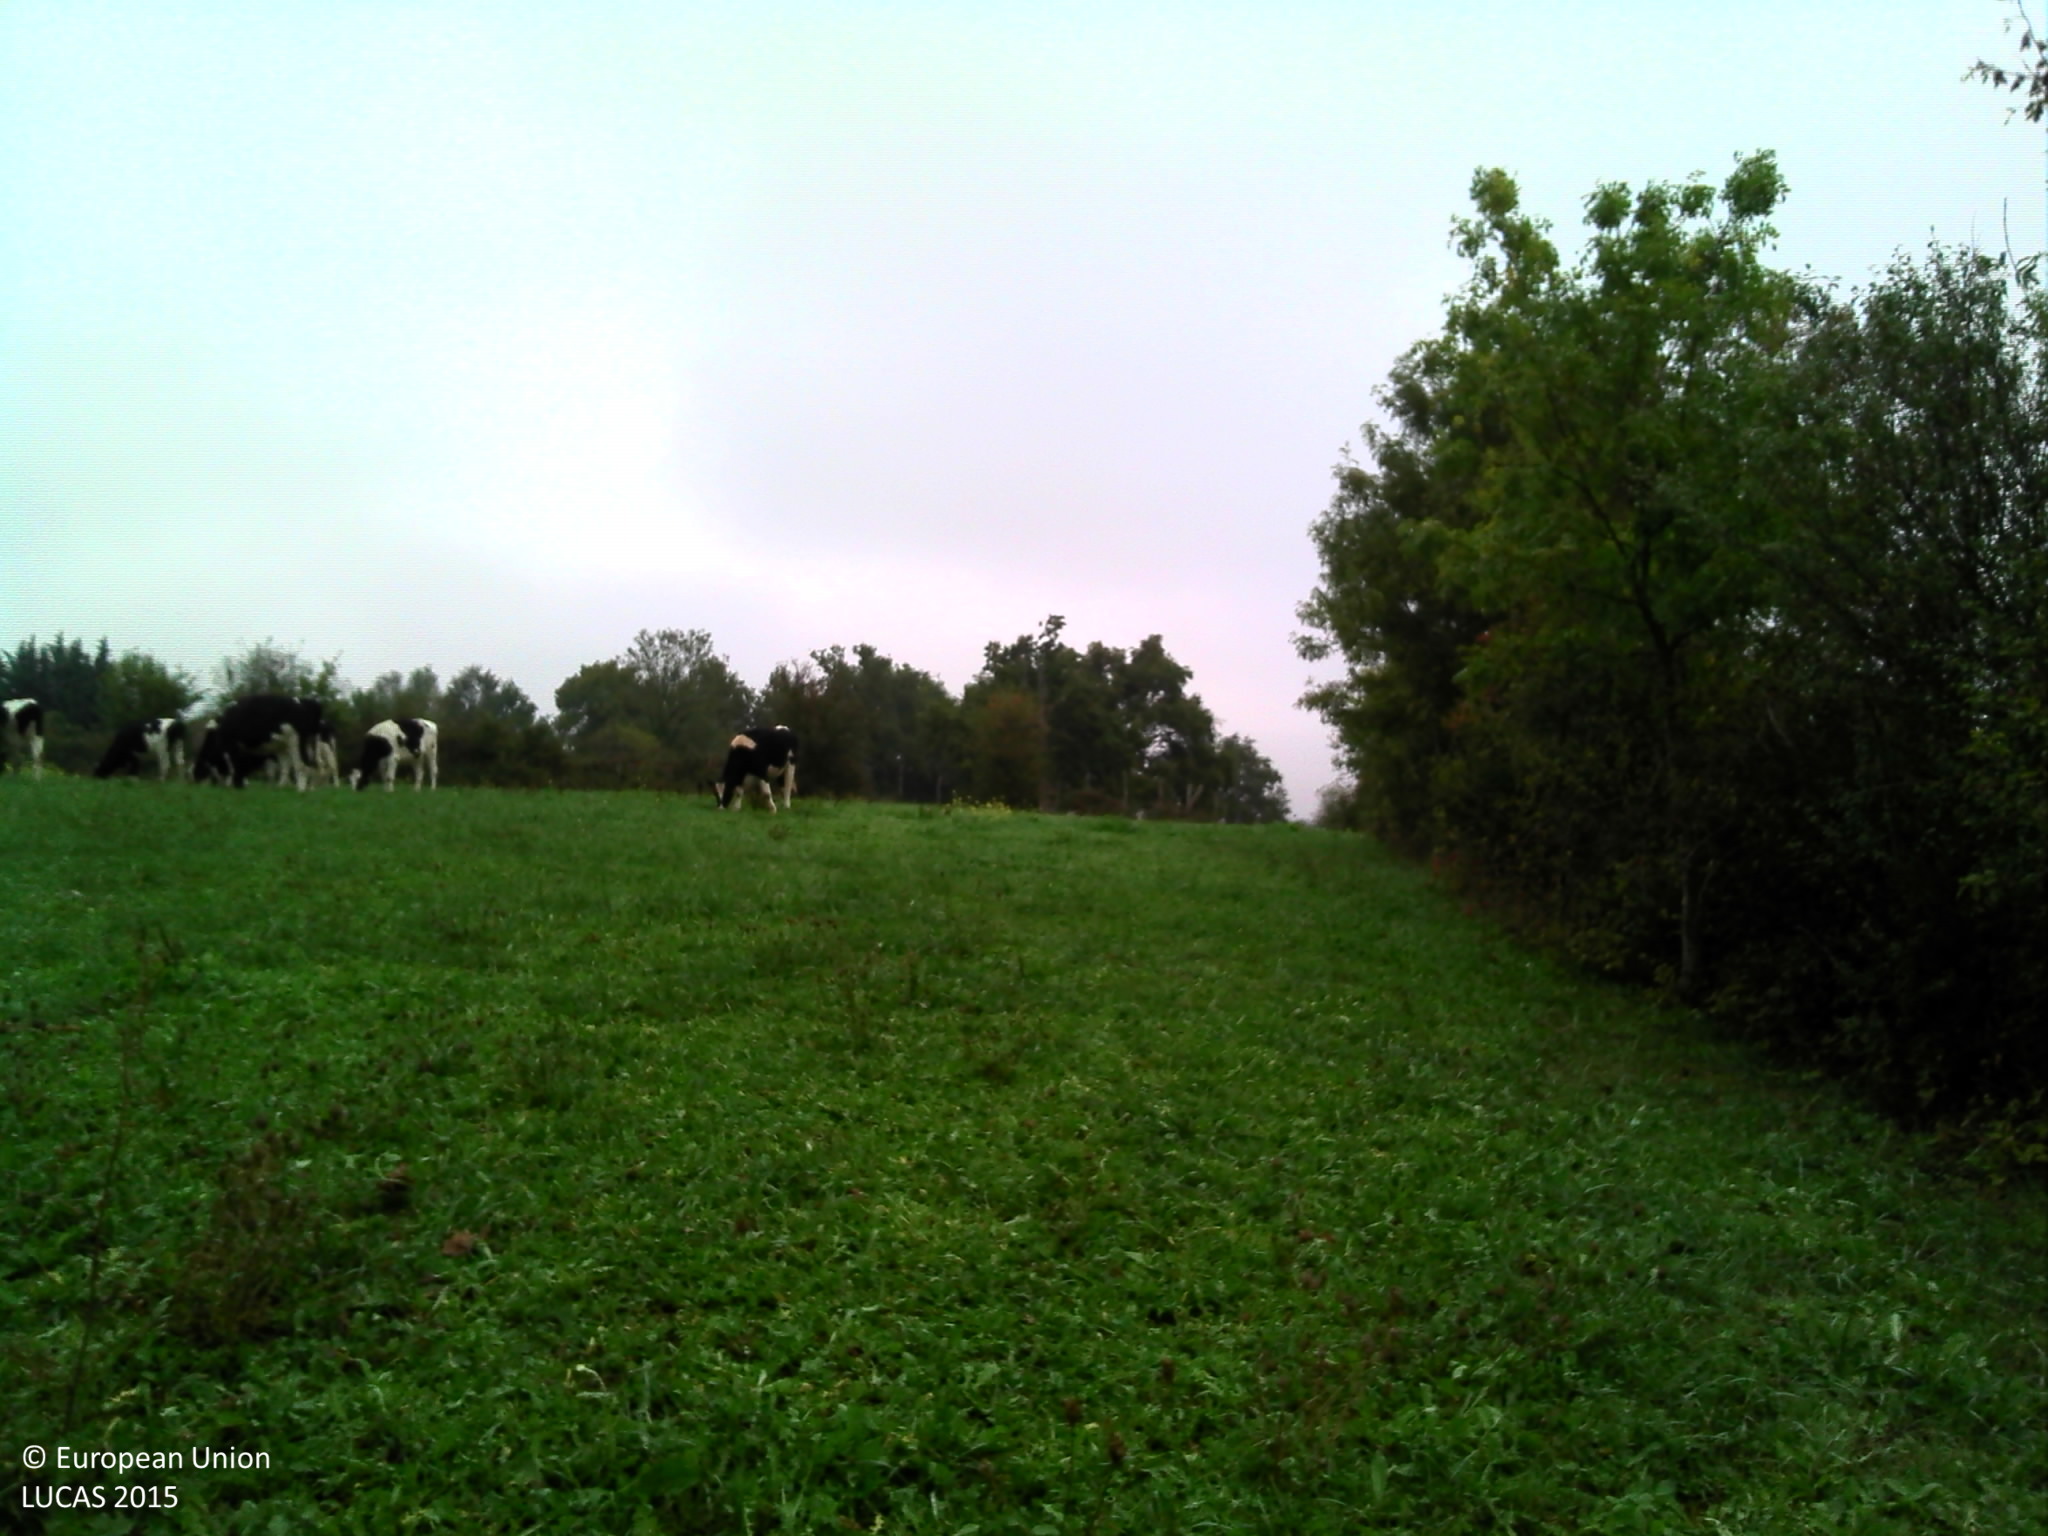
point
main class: Grassland
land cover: Grassland without tree/shrub cover
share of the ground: > 75 %
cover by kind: herbaceous plants 100 %
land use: Agriculture (excluding fallow land and kitchen gardens)
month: October
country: FR
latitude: 46.3246
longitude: 5.0019
